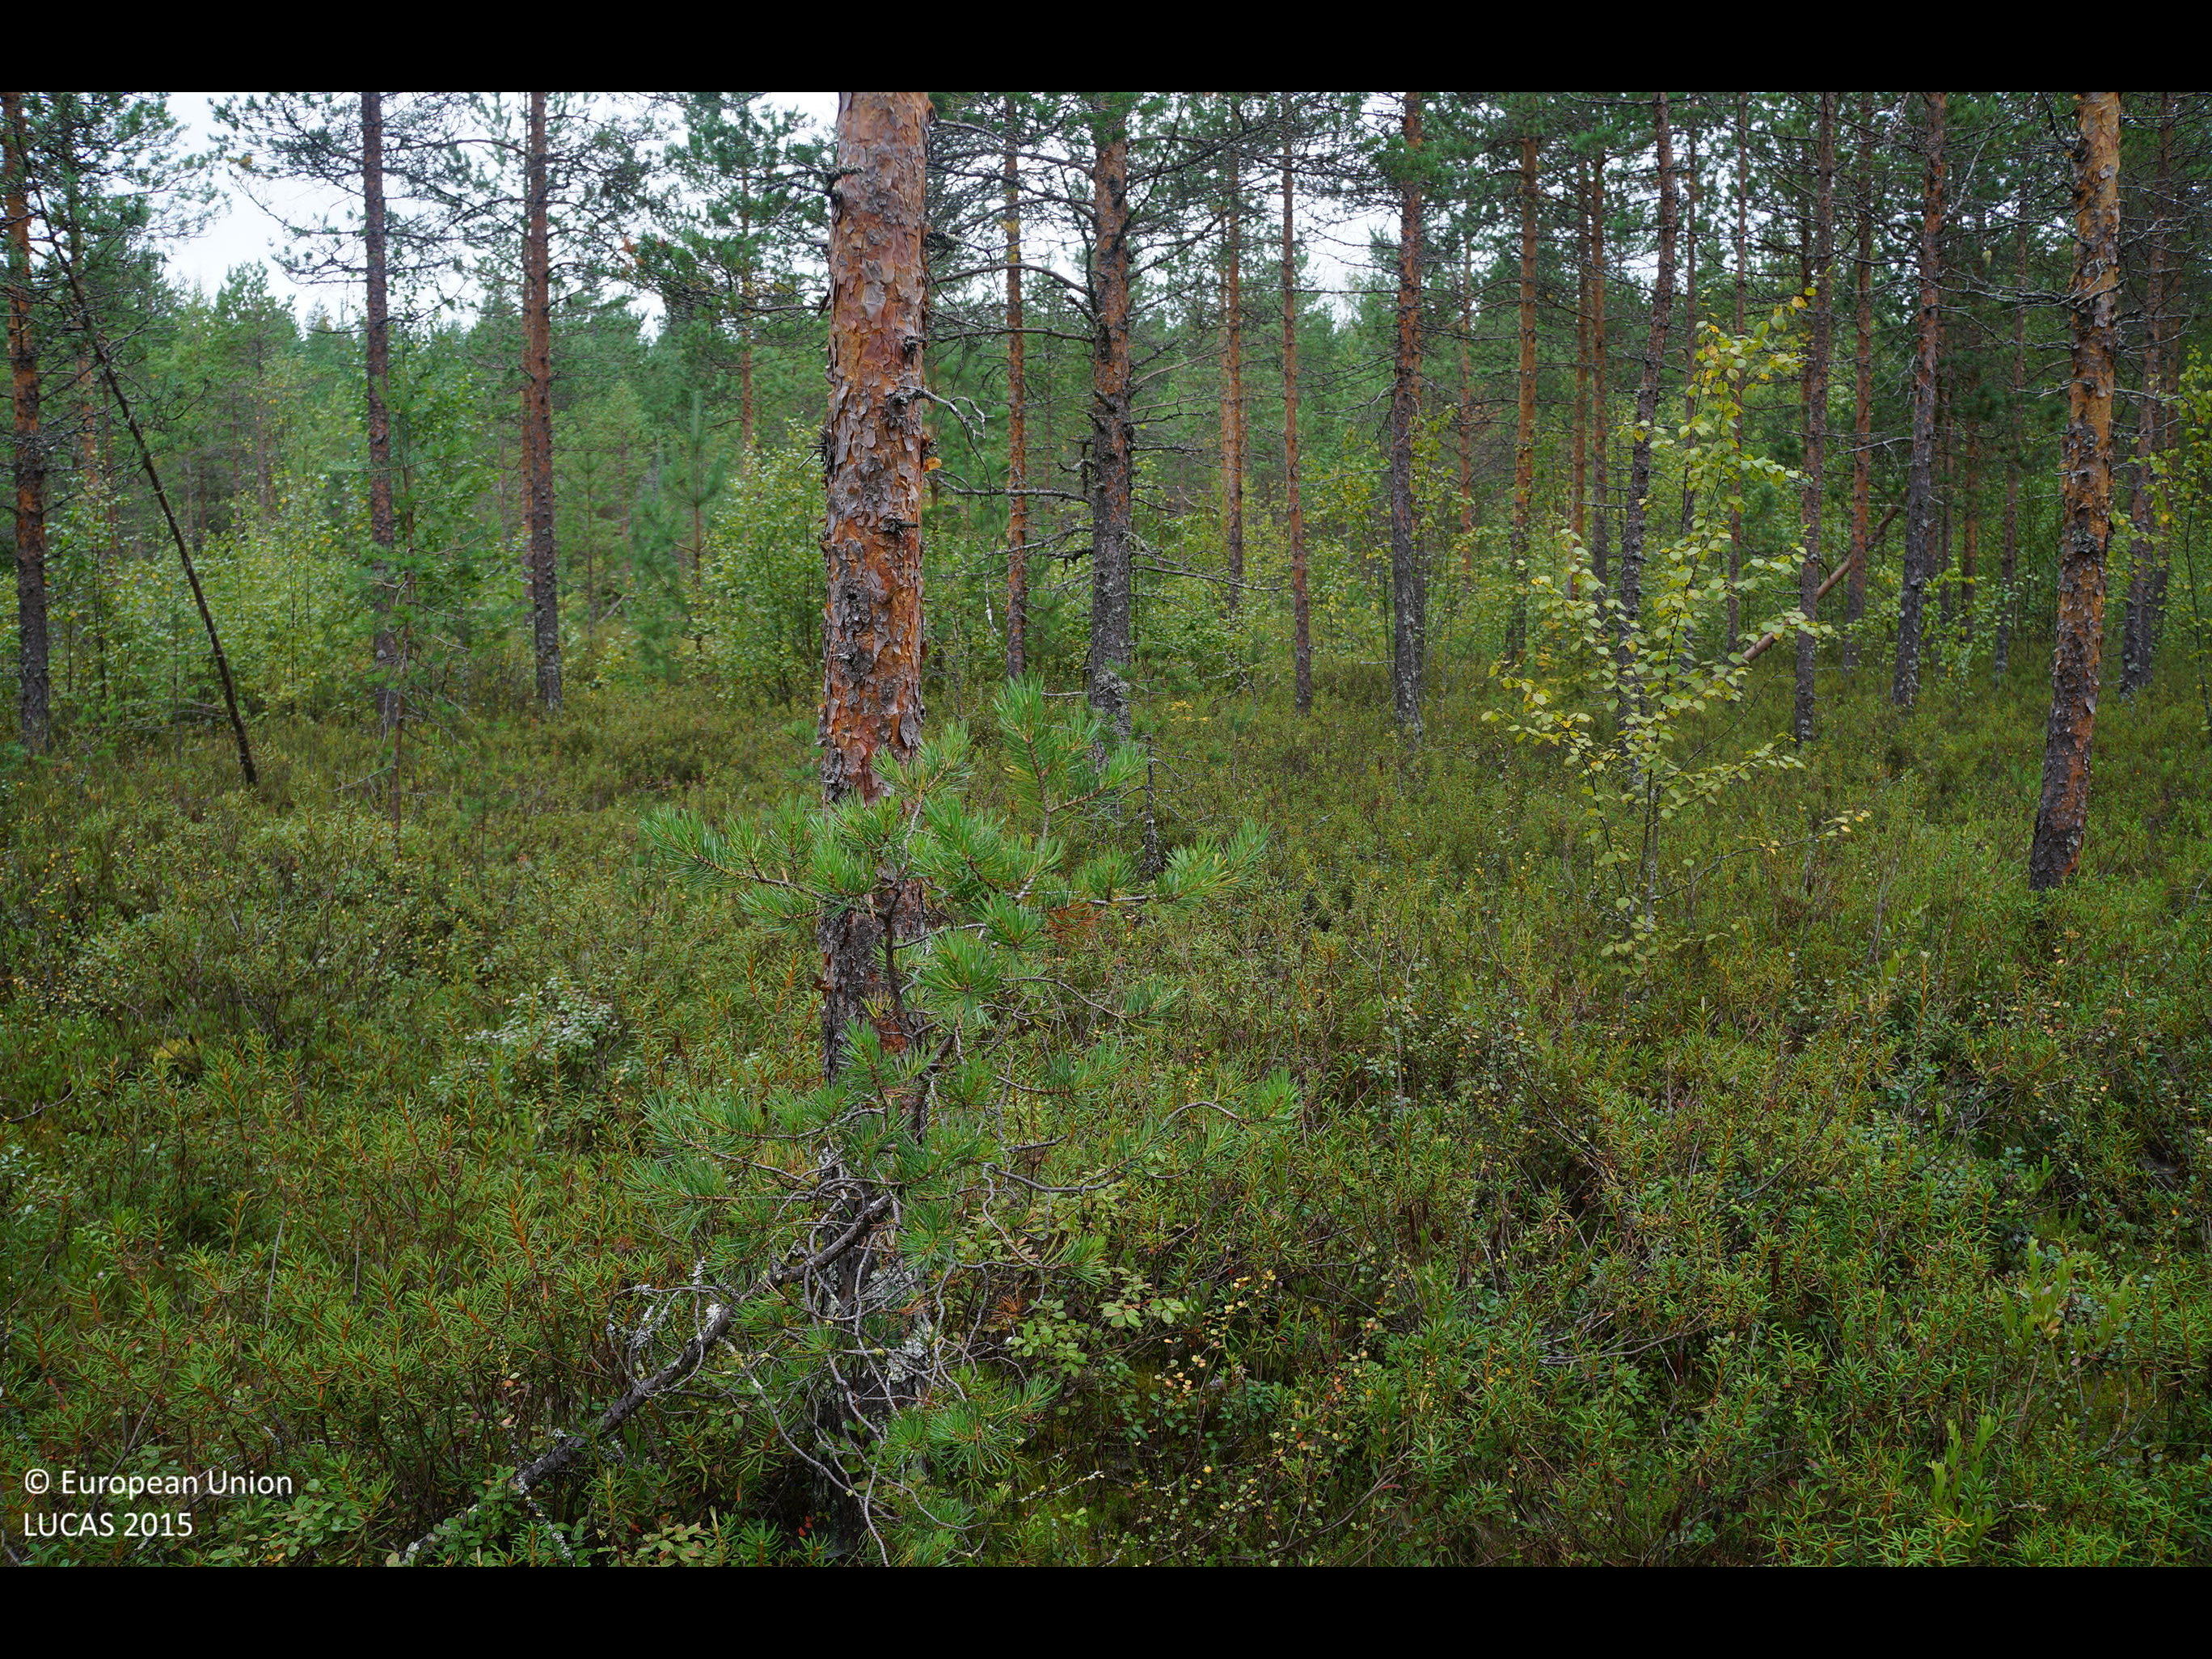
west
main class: Woodland
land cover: Pine dominated coniferous woodland
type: boreal forest
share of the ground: 25 - 50 %
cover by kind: coniferous forest trees 40 %, shrubs 40 %, lichens and mosses 20 %
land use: Forestry
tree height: > 5 m
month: August
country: FI
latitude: 64.2685
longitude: 25.7678
